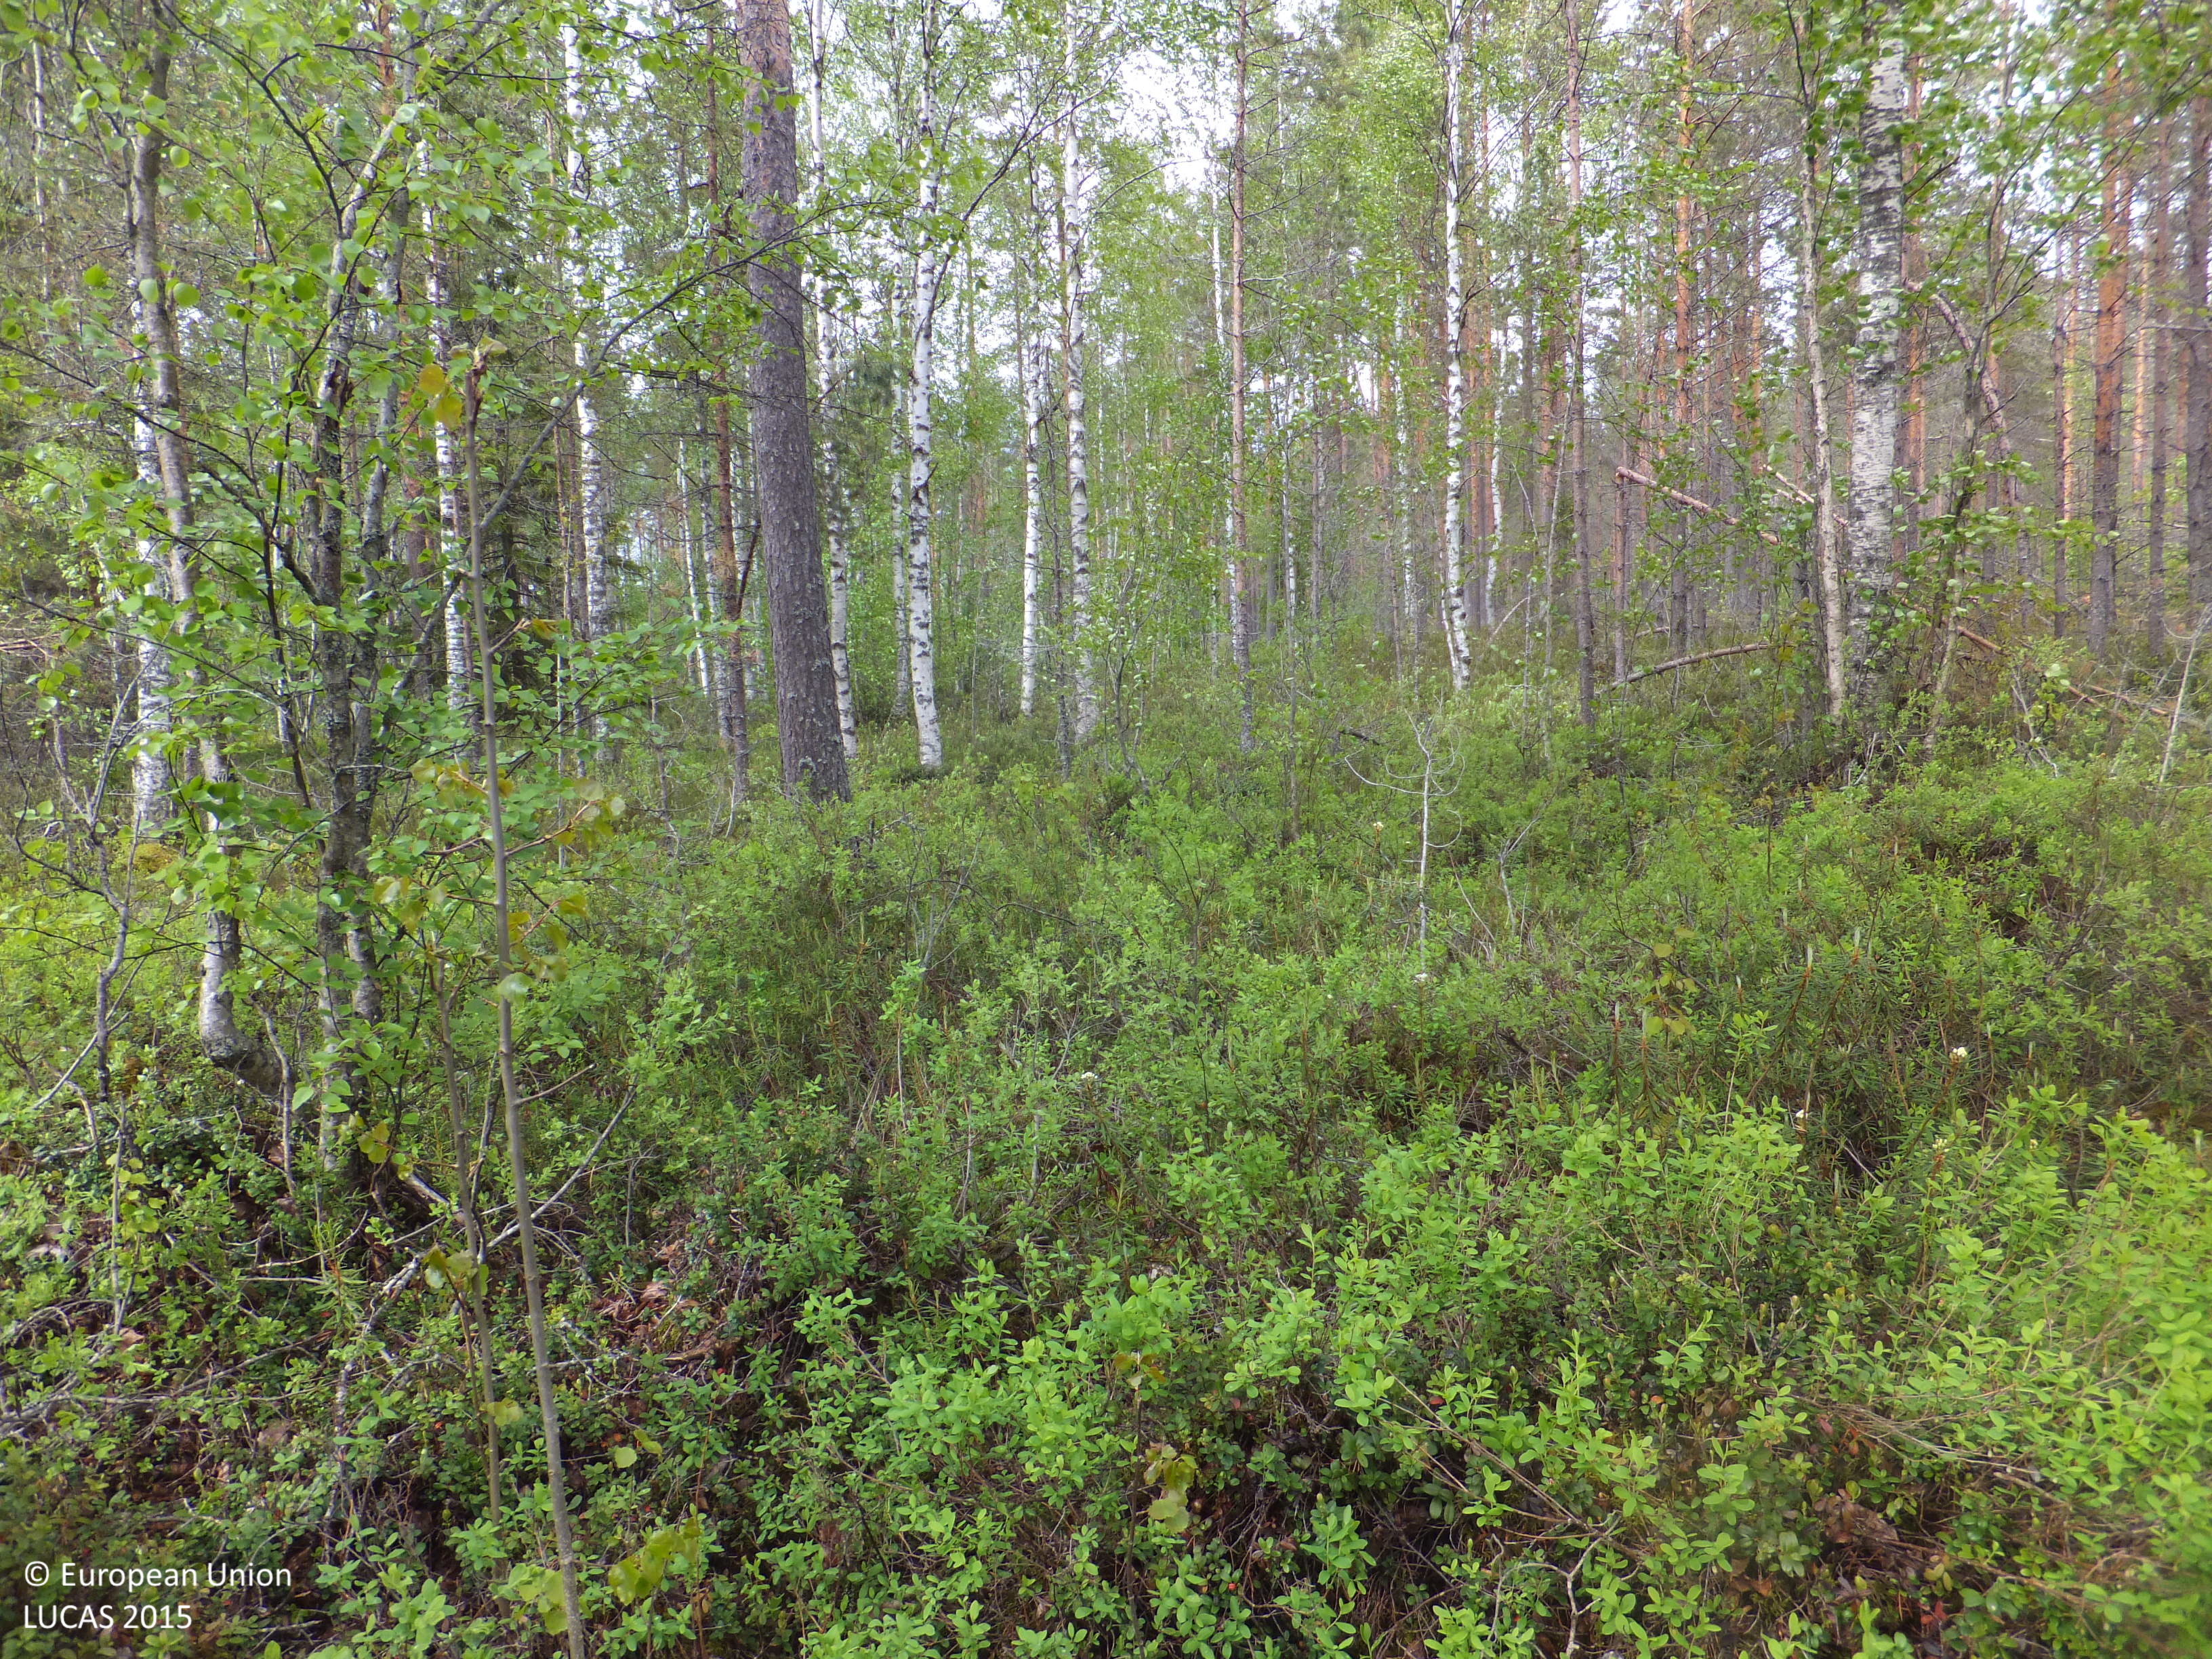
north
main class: Woodland
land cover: Pine dominated mixed woodland
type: boreal forest
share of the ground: 50 - 75 %
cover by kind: broadleaved forest trees 40 %, coniferous forest trees 30 %, shrubs 15 %, lichens and mosses 15 %
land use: Forestry
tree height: > 5 m
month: June
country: FI
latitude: 63.6149
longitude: 23.9240
